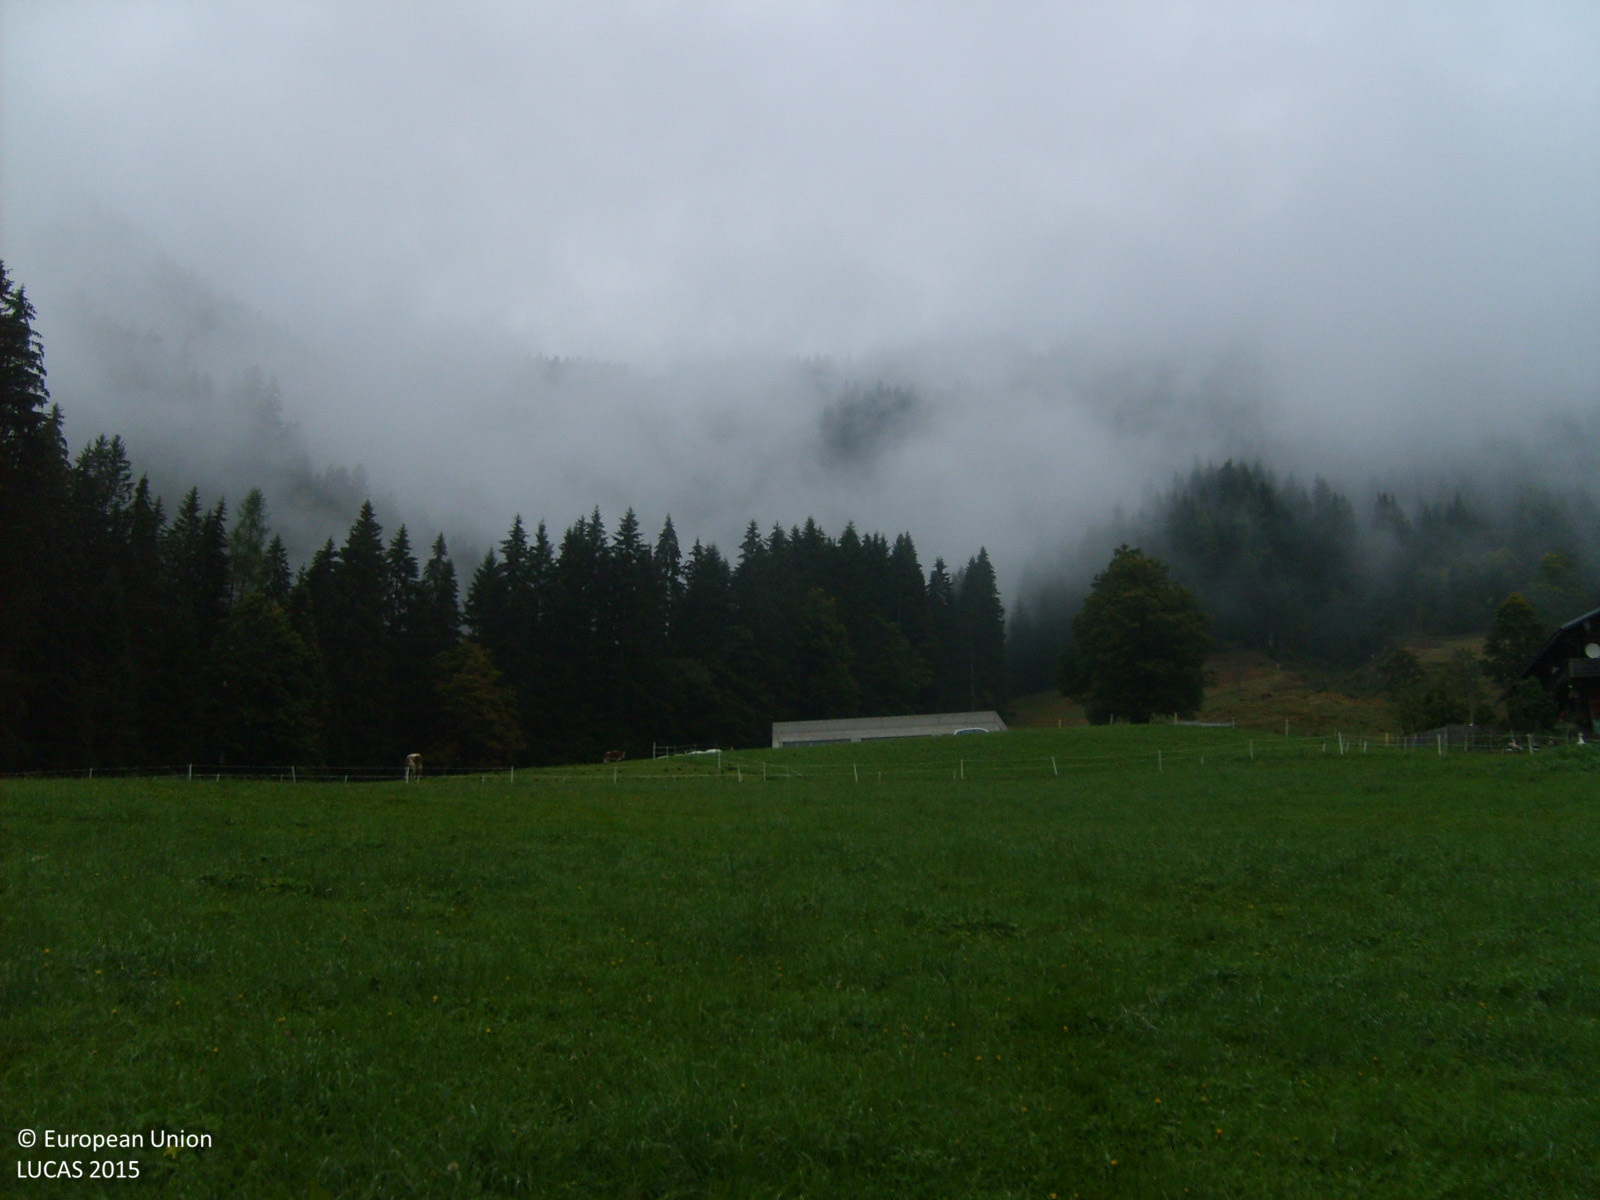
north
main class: Grassland
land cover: Grassland without tree/shrub cover
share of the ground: > 75 %
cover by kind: herbaceous plants 100 %
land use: Agriculture (excluding fallow land and kitchen gardens)
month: September
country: AT
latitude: 47.4357
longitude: 13.2997
